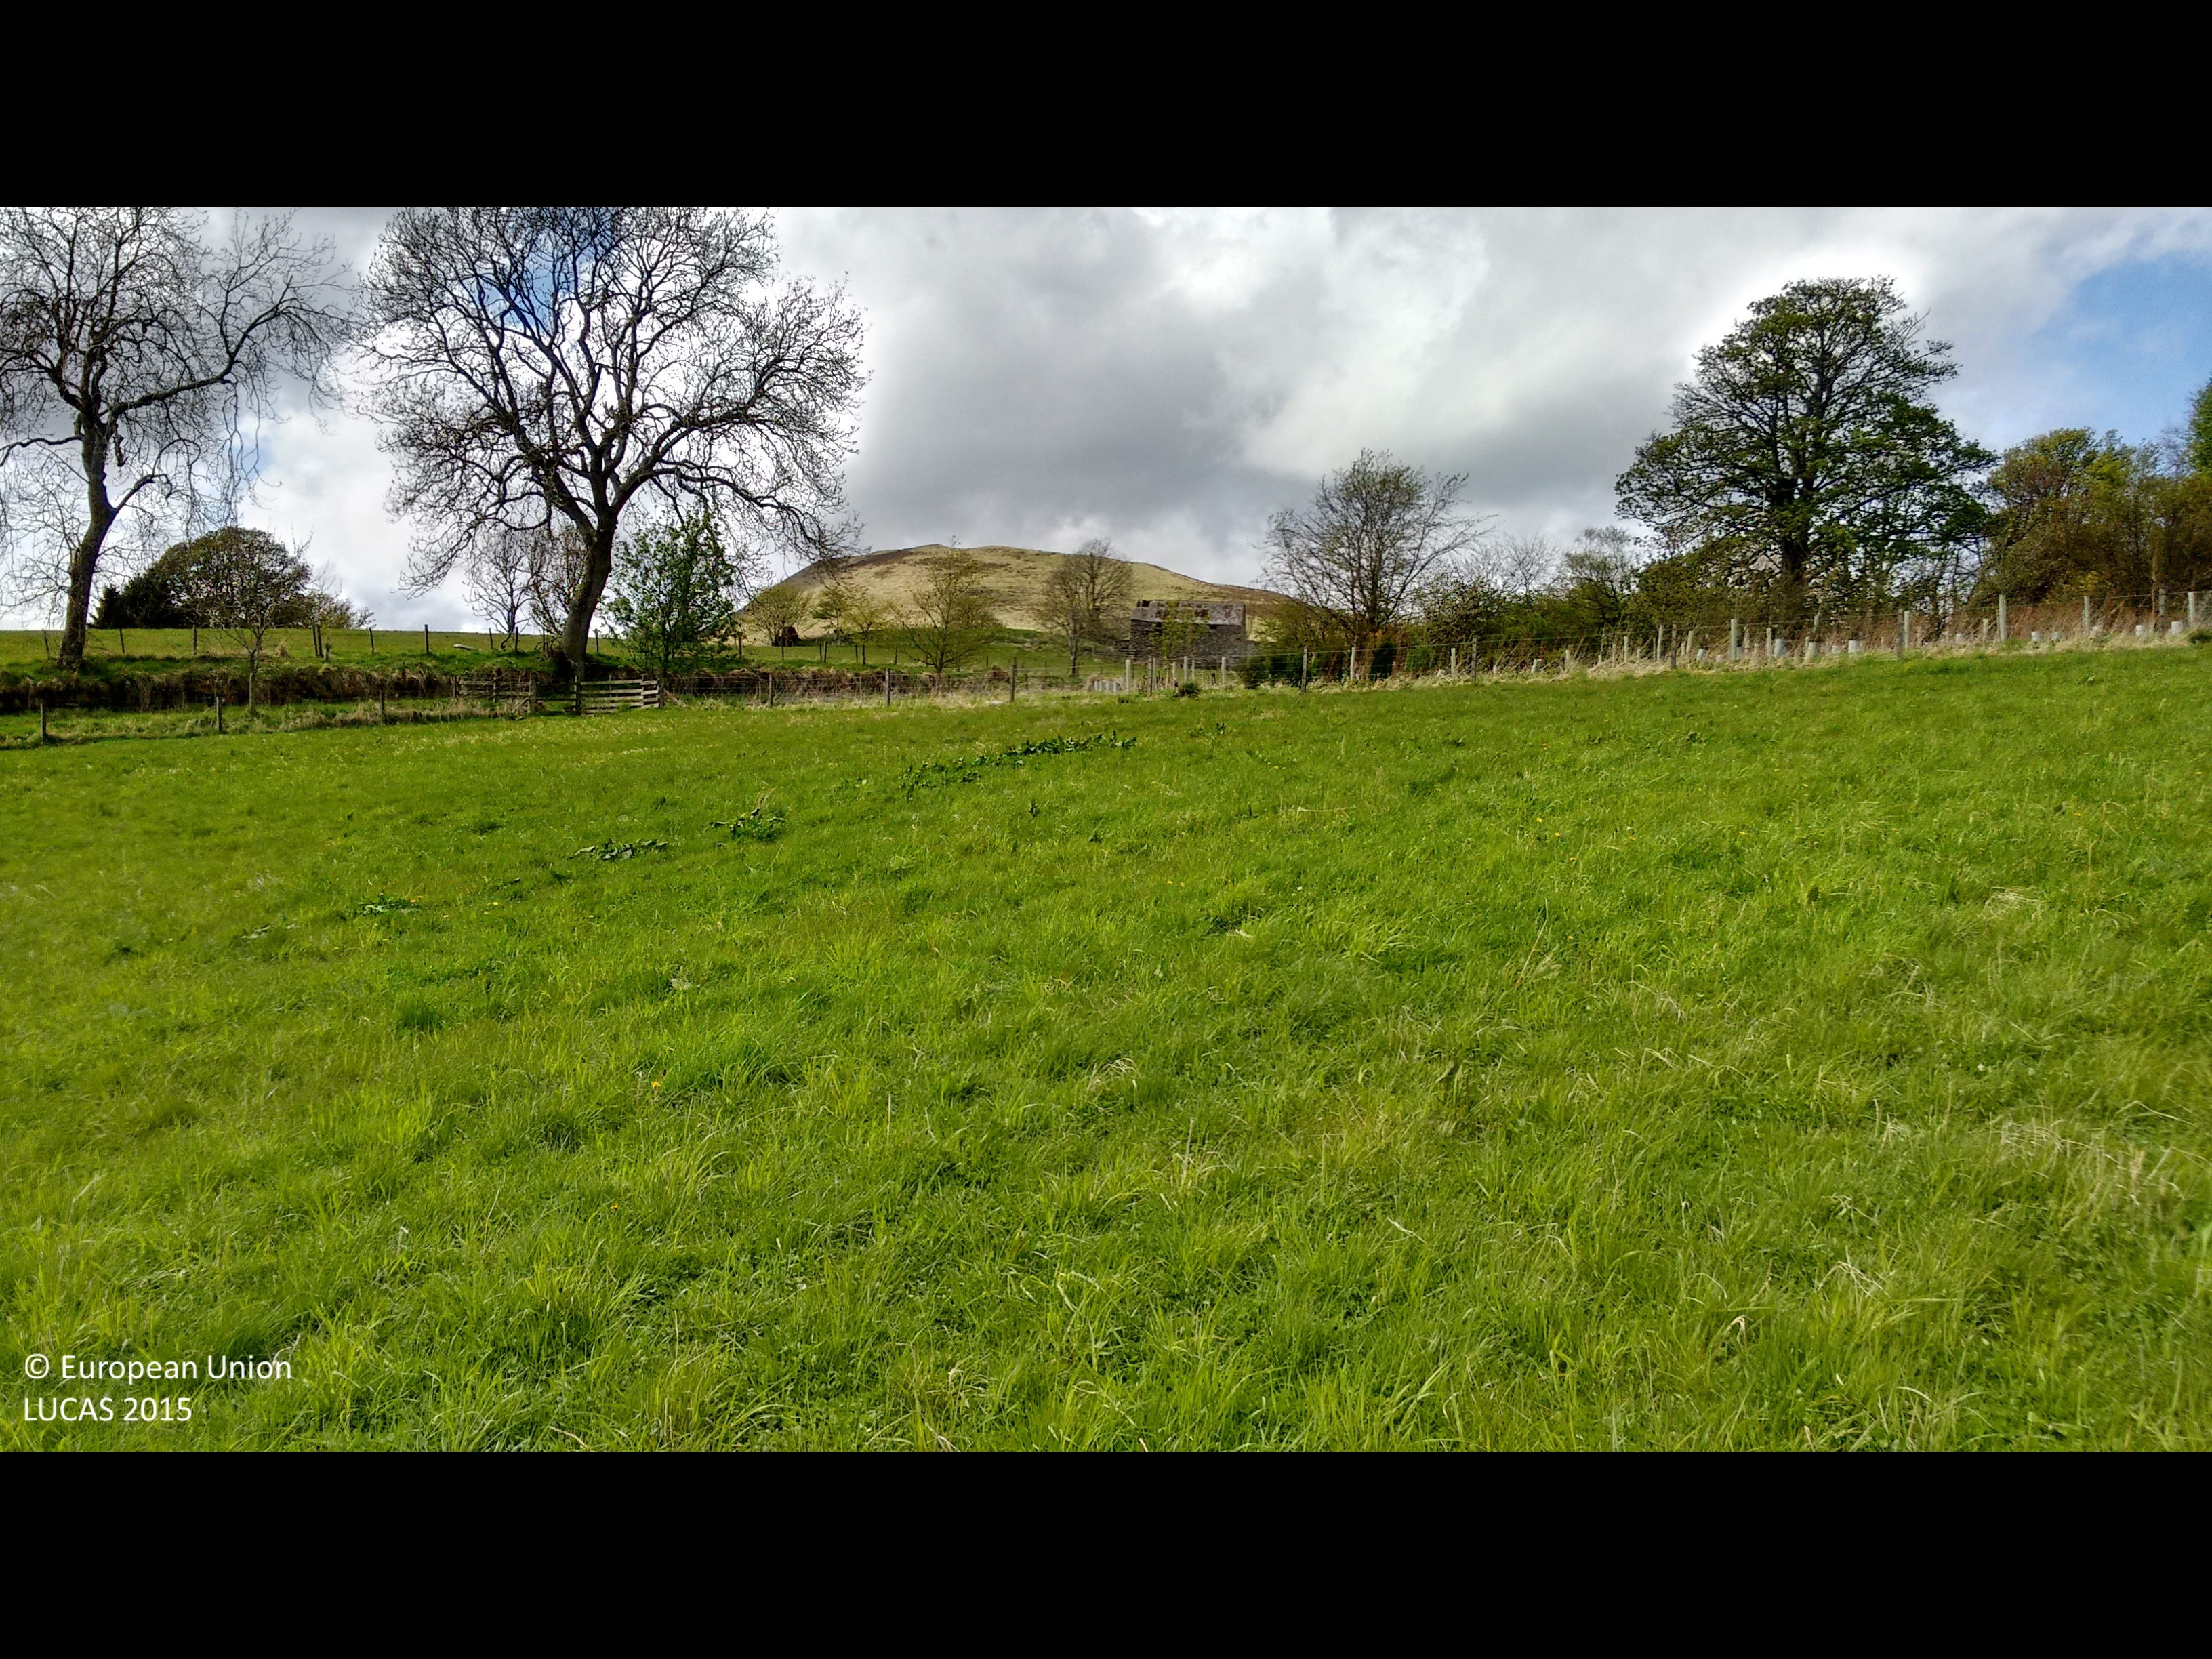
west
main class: Grassland
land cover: Grassland without tree/shrub cover
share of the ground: > 75 %
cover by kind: herbaceous plants 100 %
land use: Agriculture (excluding fallow land and kitchen gardens)
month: May
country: GB
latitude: 56.5284
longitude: -3.1558
